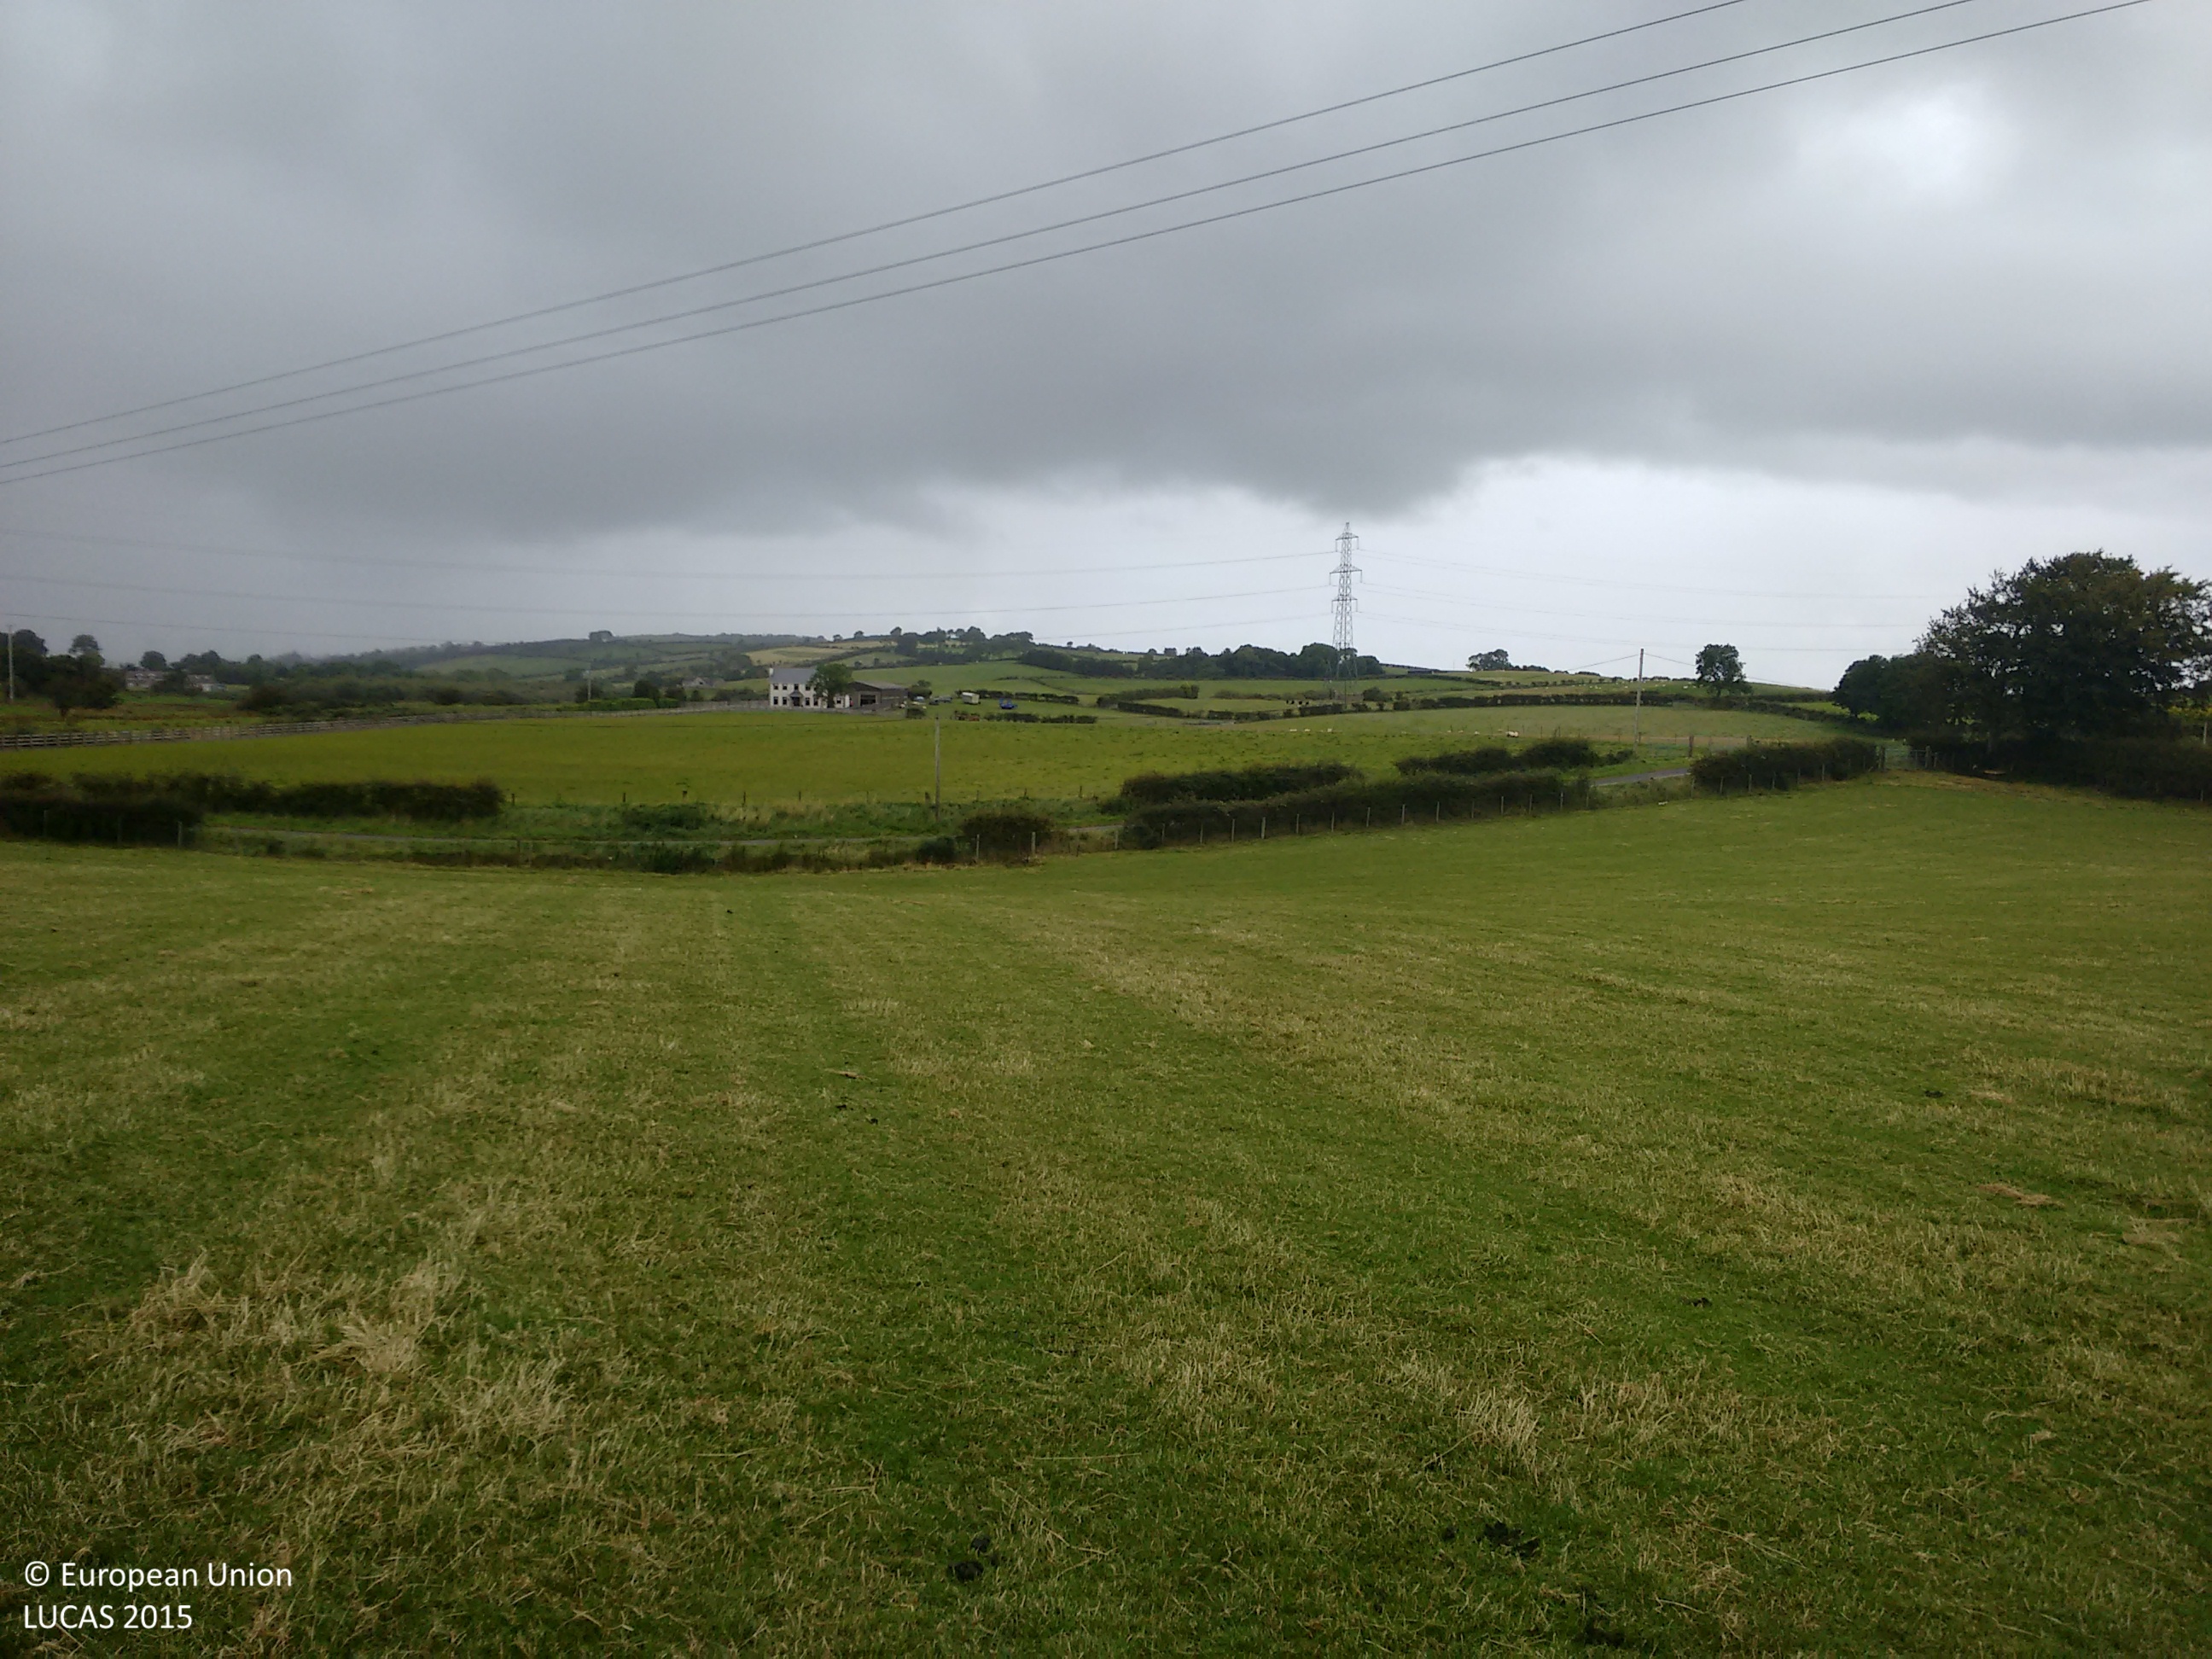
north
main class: Grassland
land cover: Grassland without tree/shrub cover
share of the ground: > 75 %
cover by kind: herbaceous plants 100 %
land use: Agriculture (excluding fallow land and kitchen gardens)
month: September
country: GB
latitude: 54.7785
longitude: -5.7906
